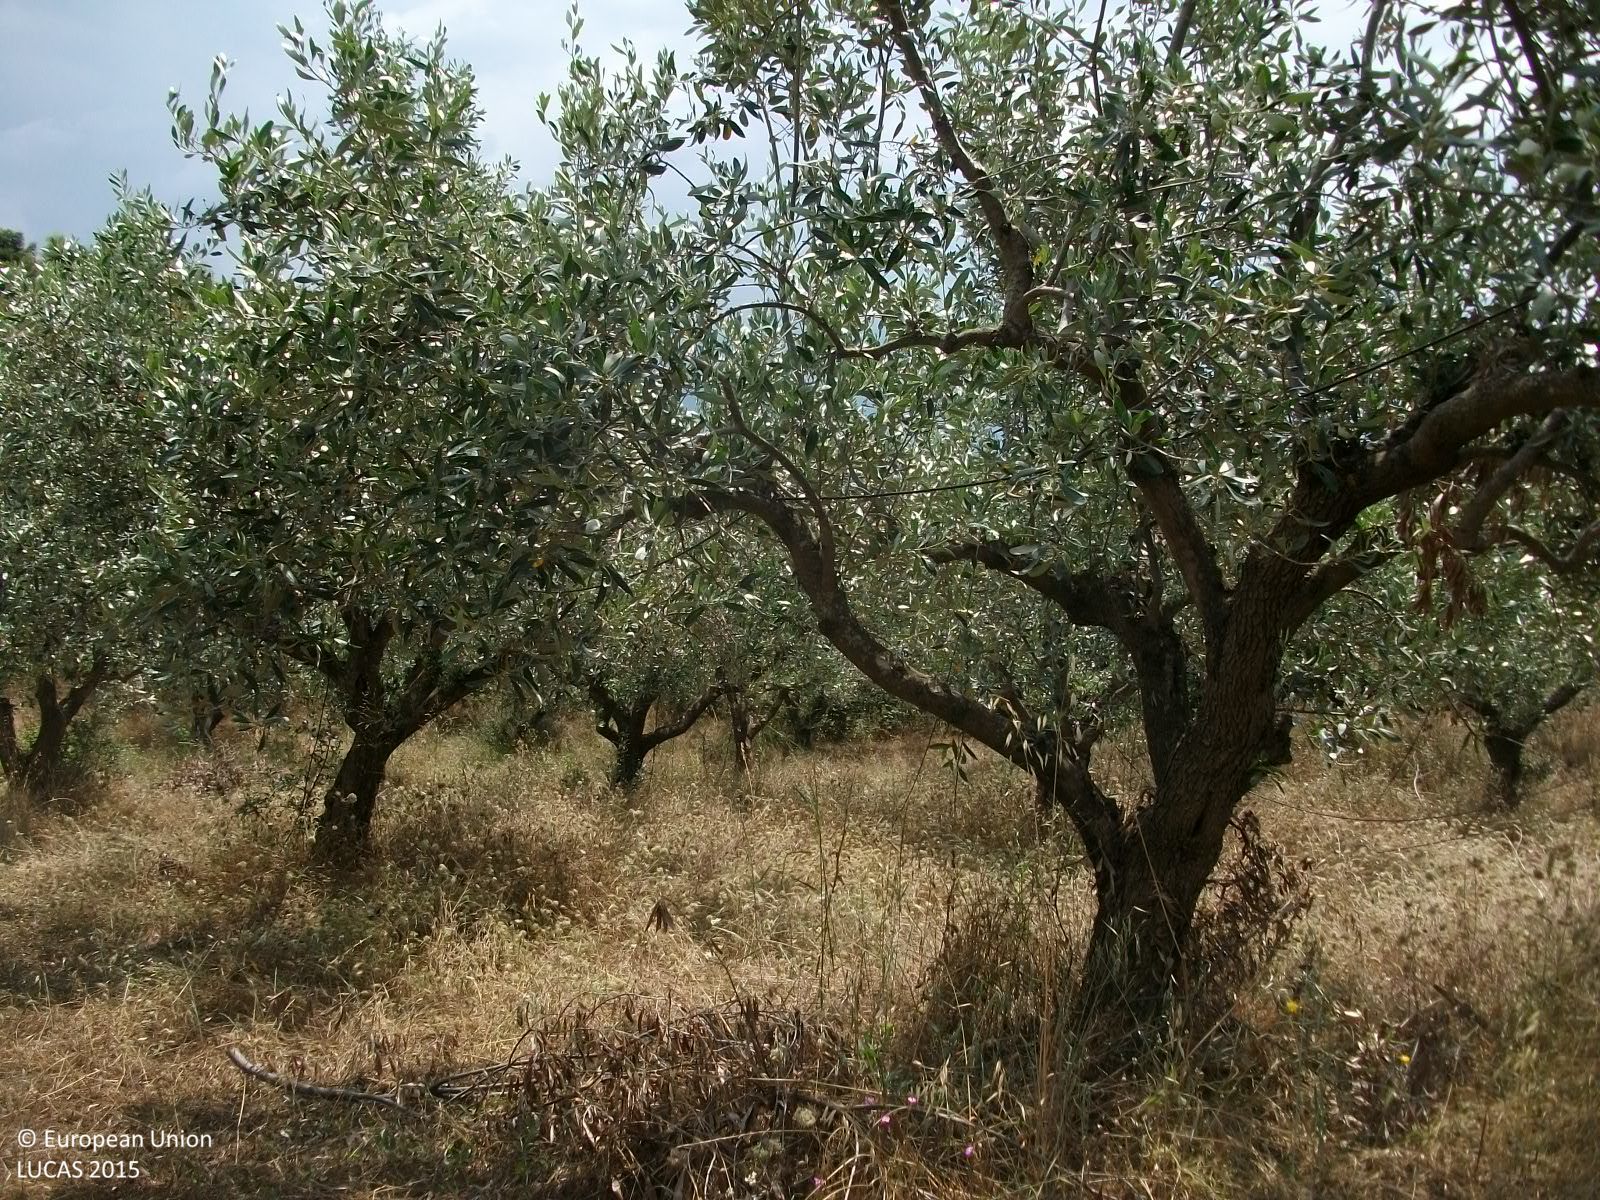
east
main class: Cropland
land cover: Olive groves
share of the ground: 50 - 75 %
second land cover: Spontaneously vegetated surfaces
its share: > 75 %
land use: Agriculture (excluding fallow land and kitchen gardens)
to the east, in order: Olive groves; Spontaneously vegetated surfaces; Shrubland with sparse tree cover; Broadleaved woodland
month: June
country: GR
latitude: 37.1647
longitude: 22.4462
